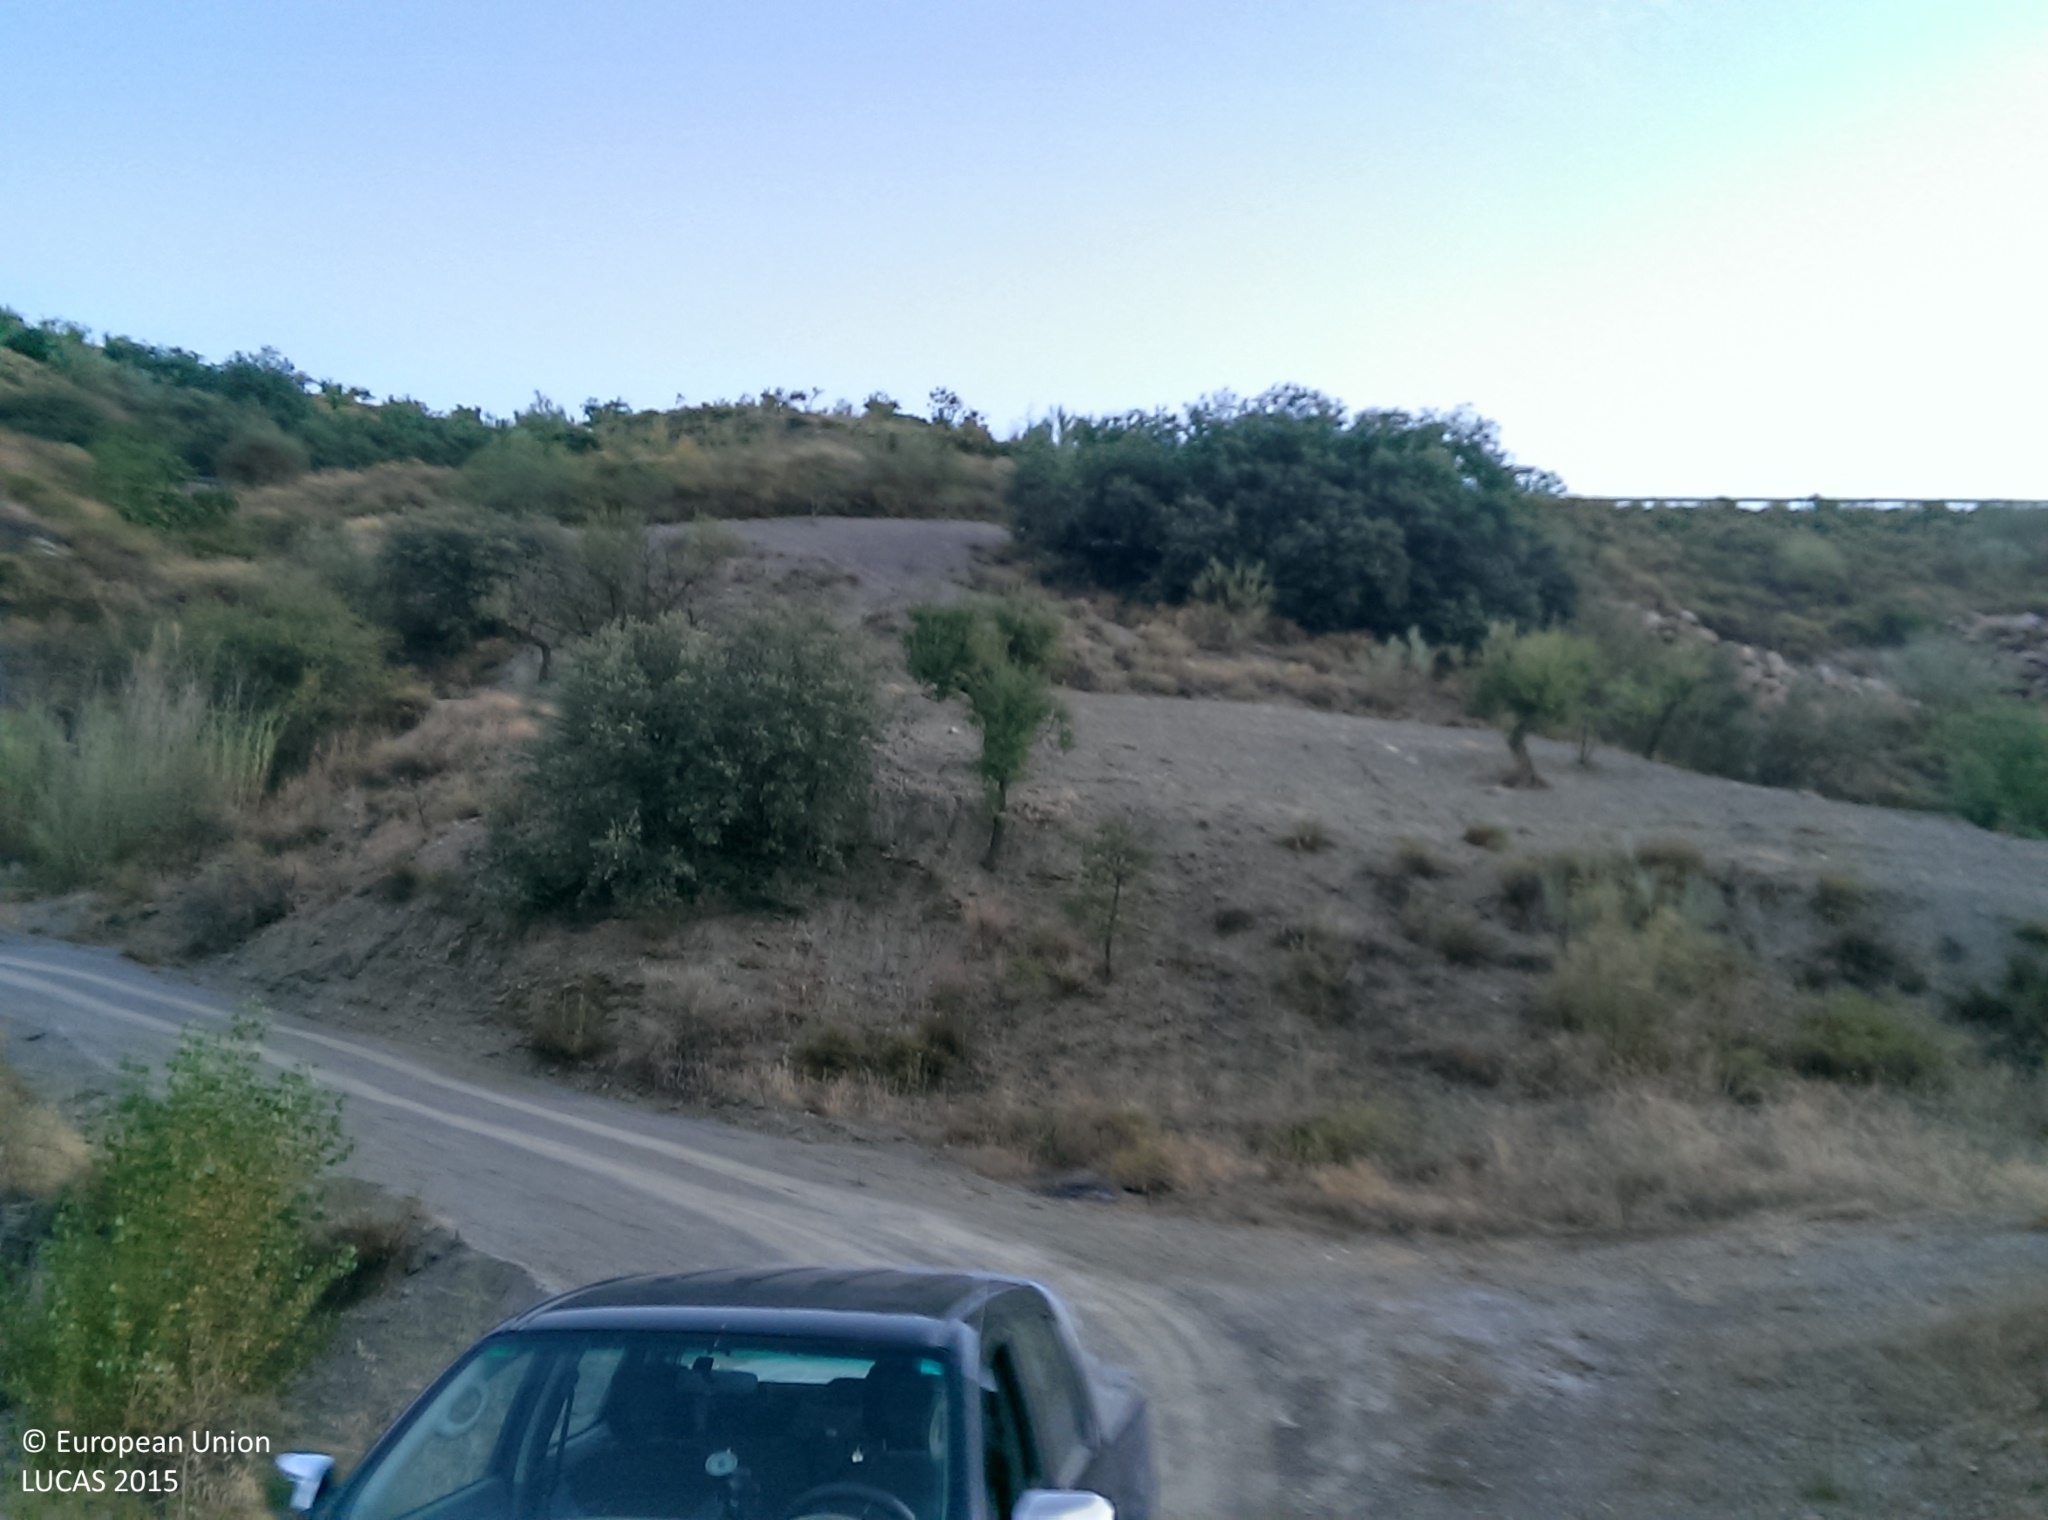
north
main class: Cropland
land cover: Nuts trees
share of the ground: 10 - 25 %
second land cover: Other bare soil
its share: > 75 %
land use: Agriculture (excluding fallow land and kitchen gardens)
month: August
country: ES
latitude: 36.9158
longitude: -3.1929
